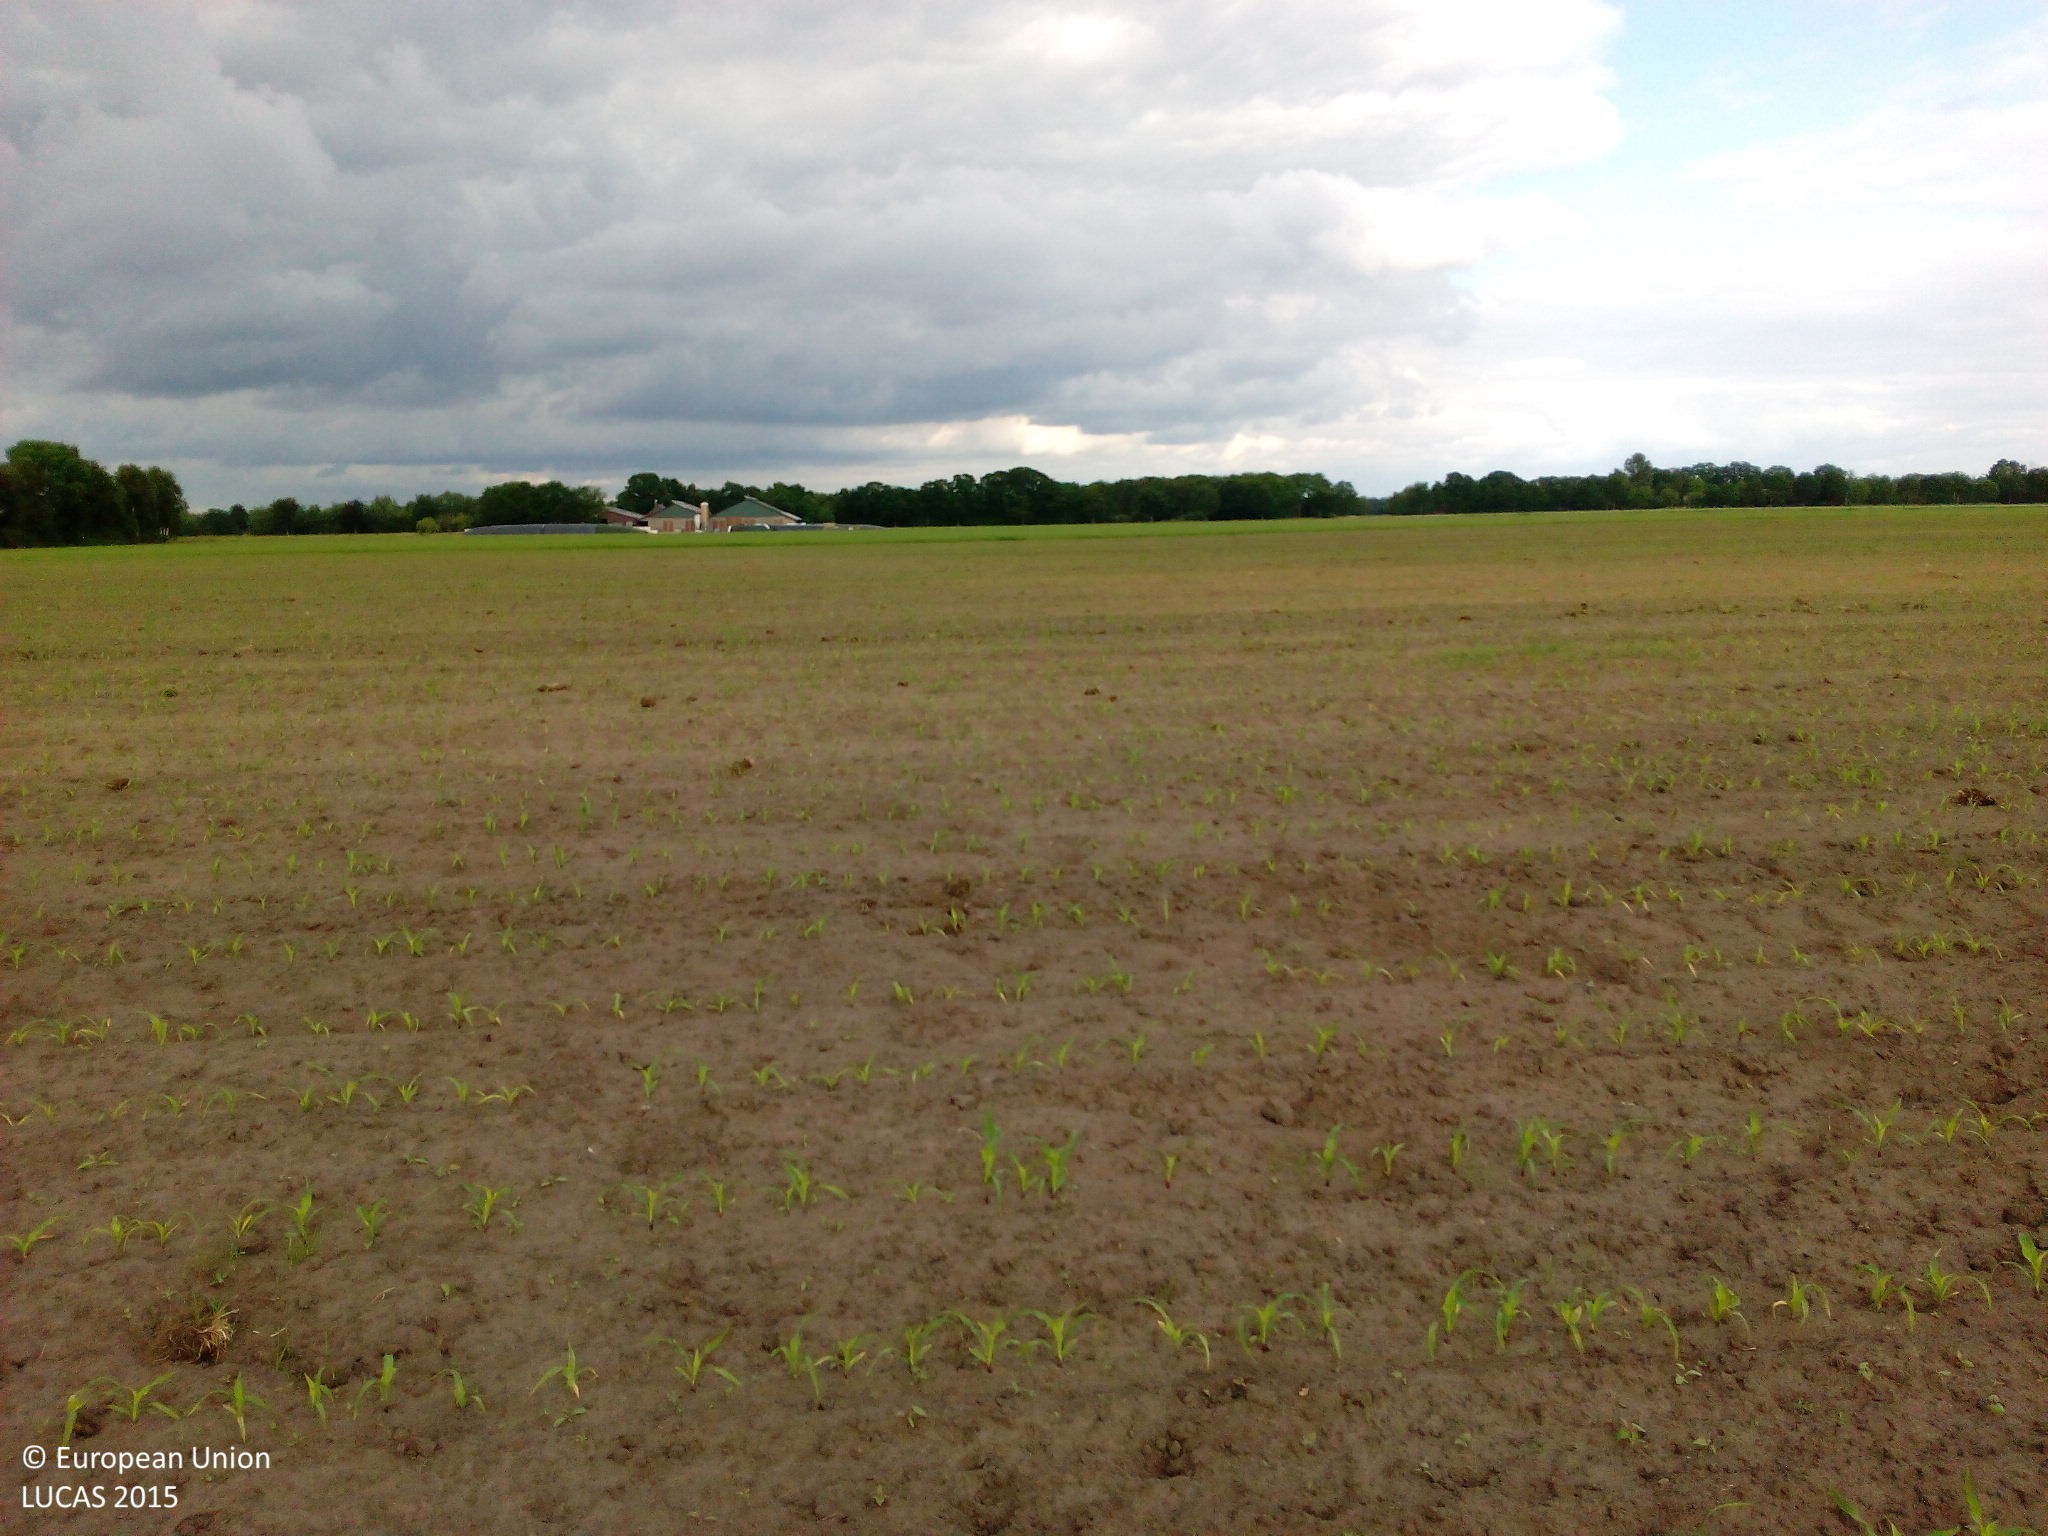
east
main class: Cropland
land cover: Maize
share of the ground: > 75 %
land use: Agriculture (excluding fallow land and kitchen gardens)
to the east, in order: Maize; Grassland without tree/shrub cover
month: June
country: DE
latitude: 52.6358
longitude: 7.3554
